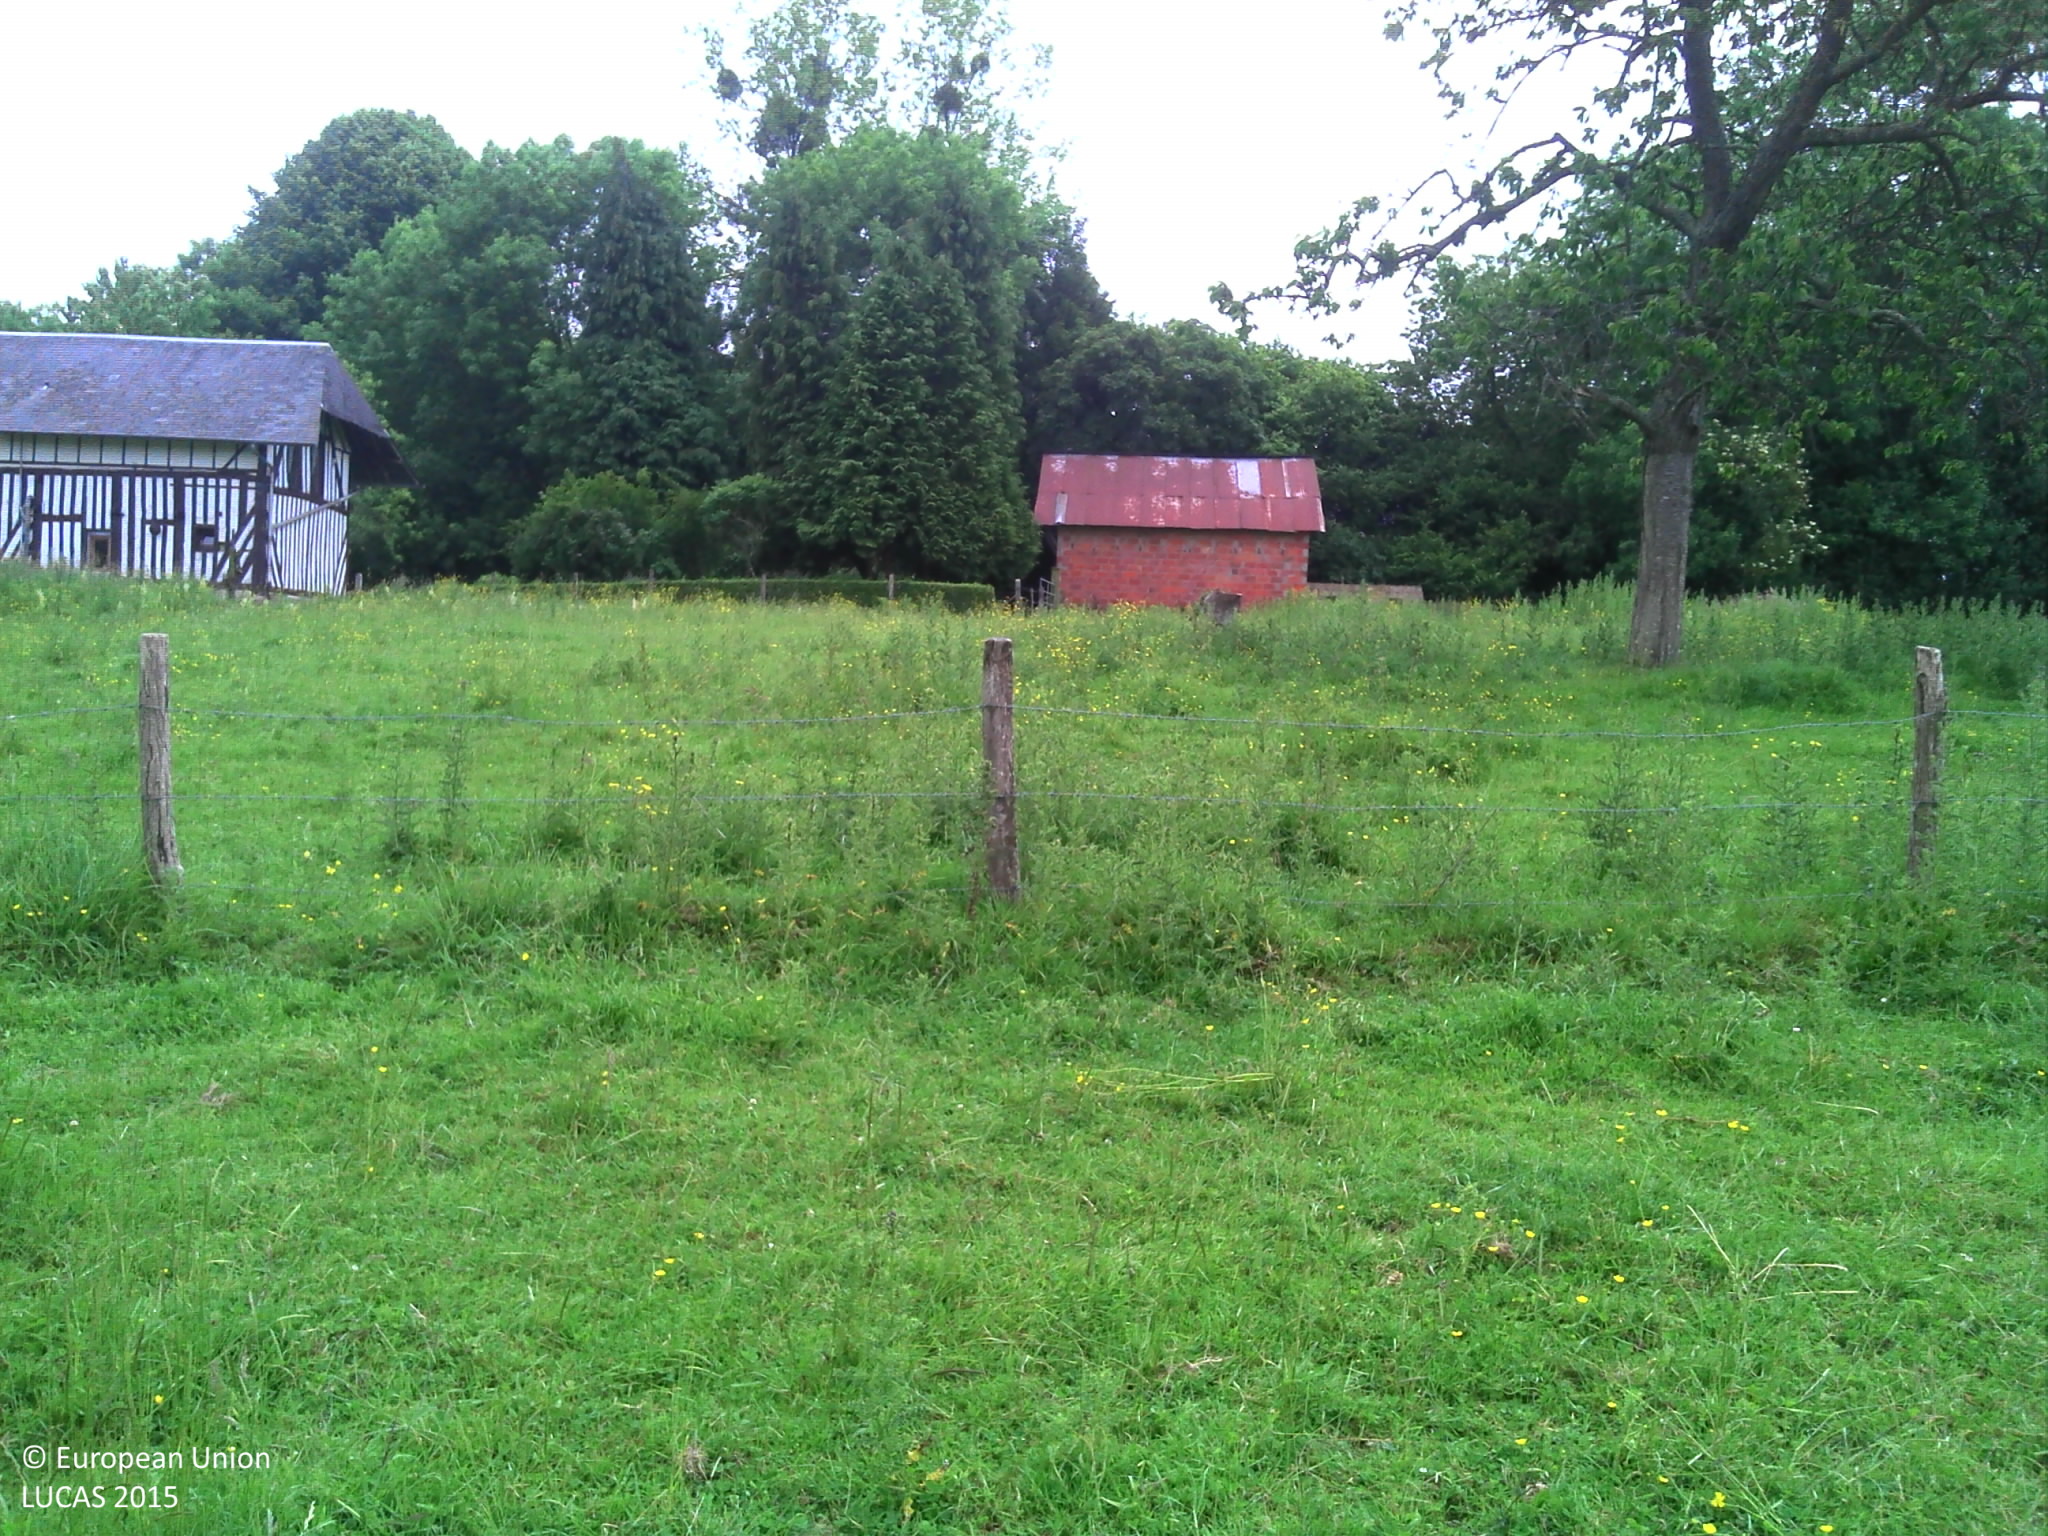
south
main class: Grassland
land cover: Grassland with sparse tree/shrub cover
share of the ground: > 75 %
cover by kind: herbaceous plants 95 %, broadleaved forest trees 5 %
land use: Agriculture (excluding fallow land and kitchen gardens)
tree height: > 5 m
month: June
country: FR
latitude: 49.2193
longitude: 0.0152
